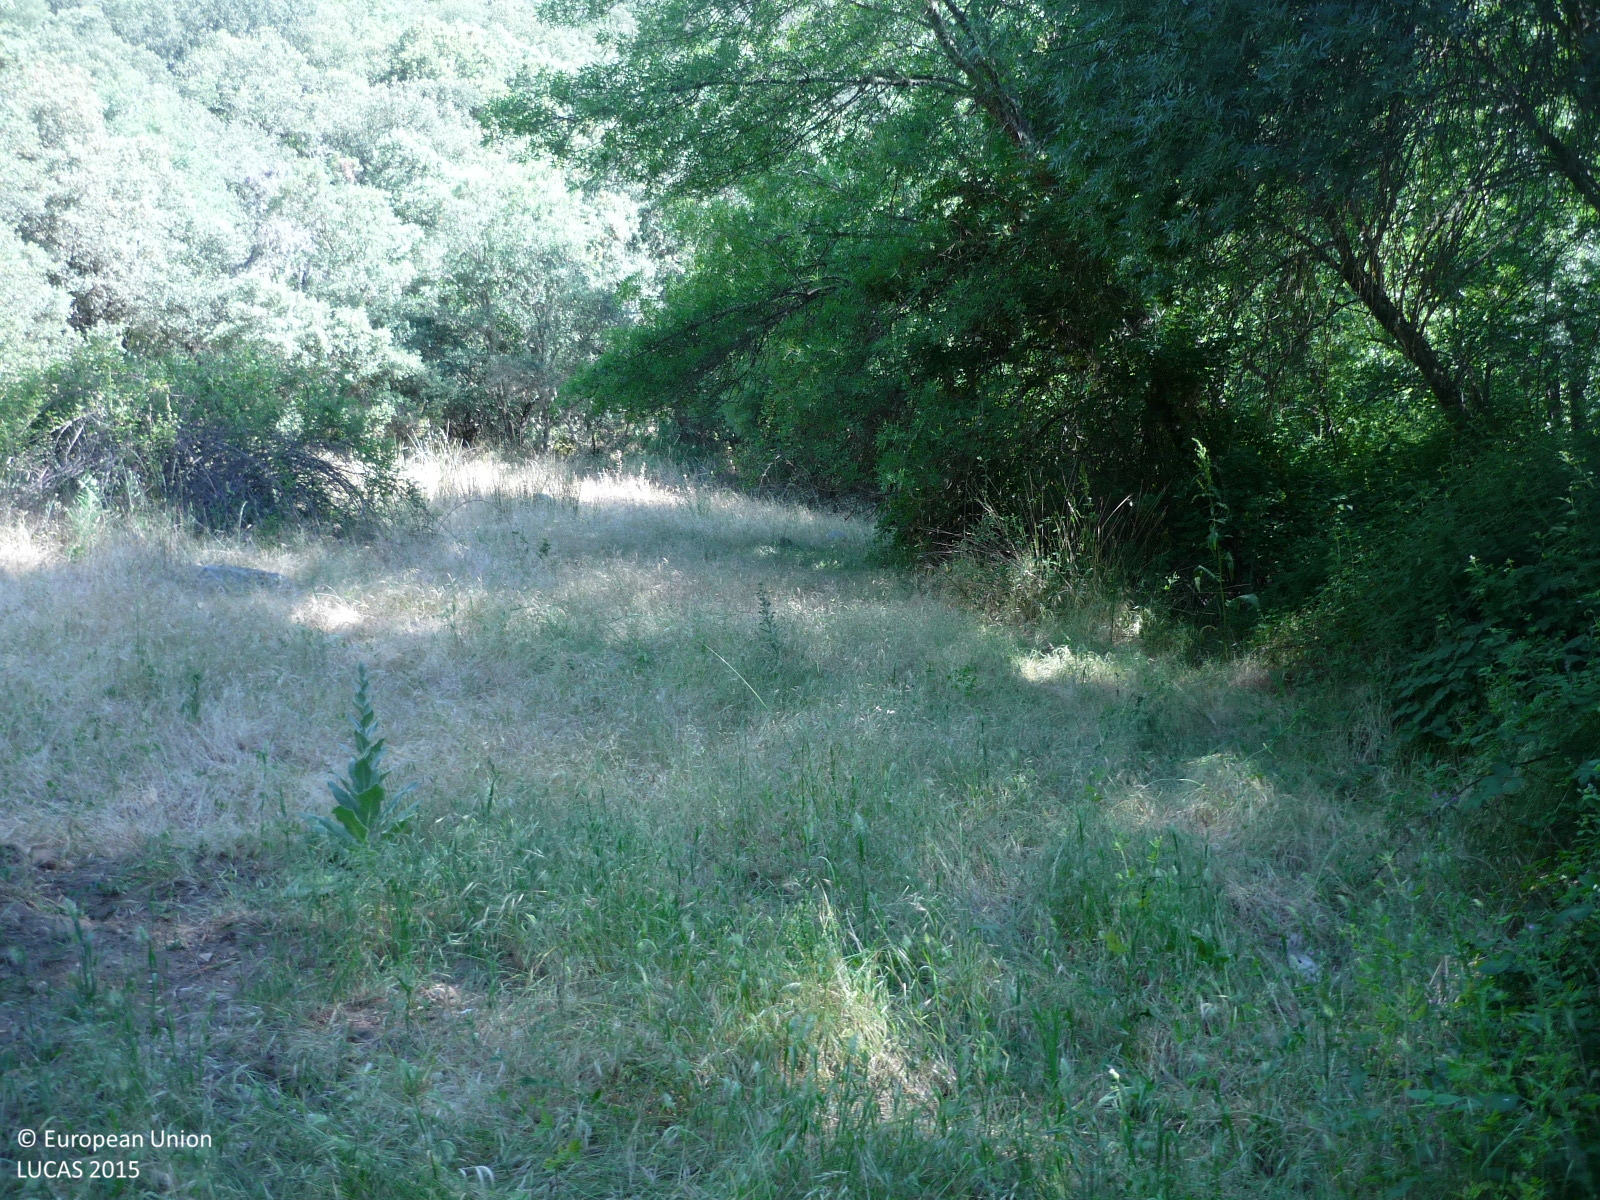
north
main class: Woodland
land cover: Broadleaved woodland
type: mesophytic deciduous forest
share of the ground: > 75 %
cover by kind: broadleaved forest trees 80 %, shrubs 10 %, herbaceous plants 10 %
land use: Semi-natural and natural areas not in use
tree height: < 5 m
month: June
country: ES
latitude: 40.7229
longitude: -3.6197
